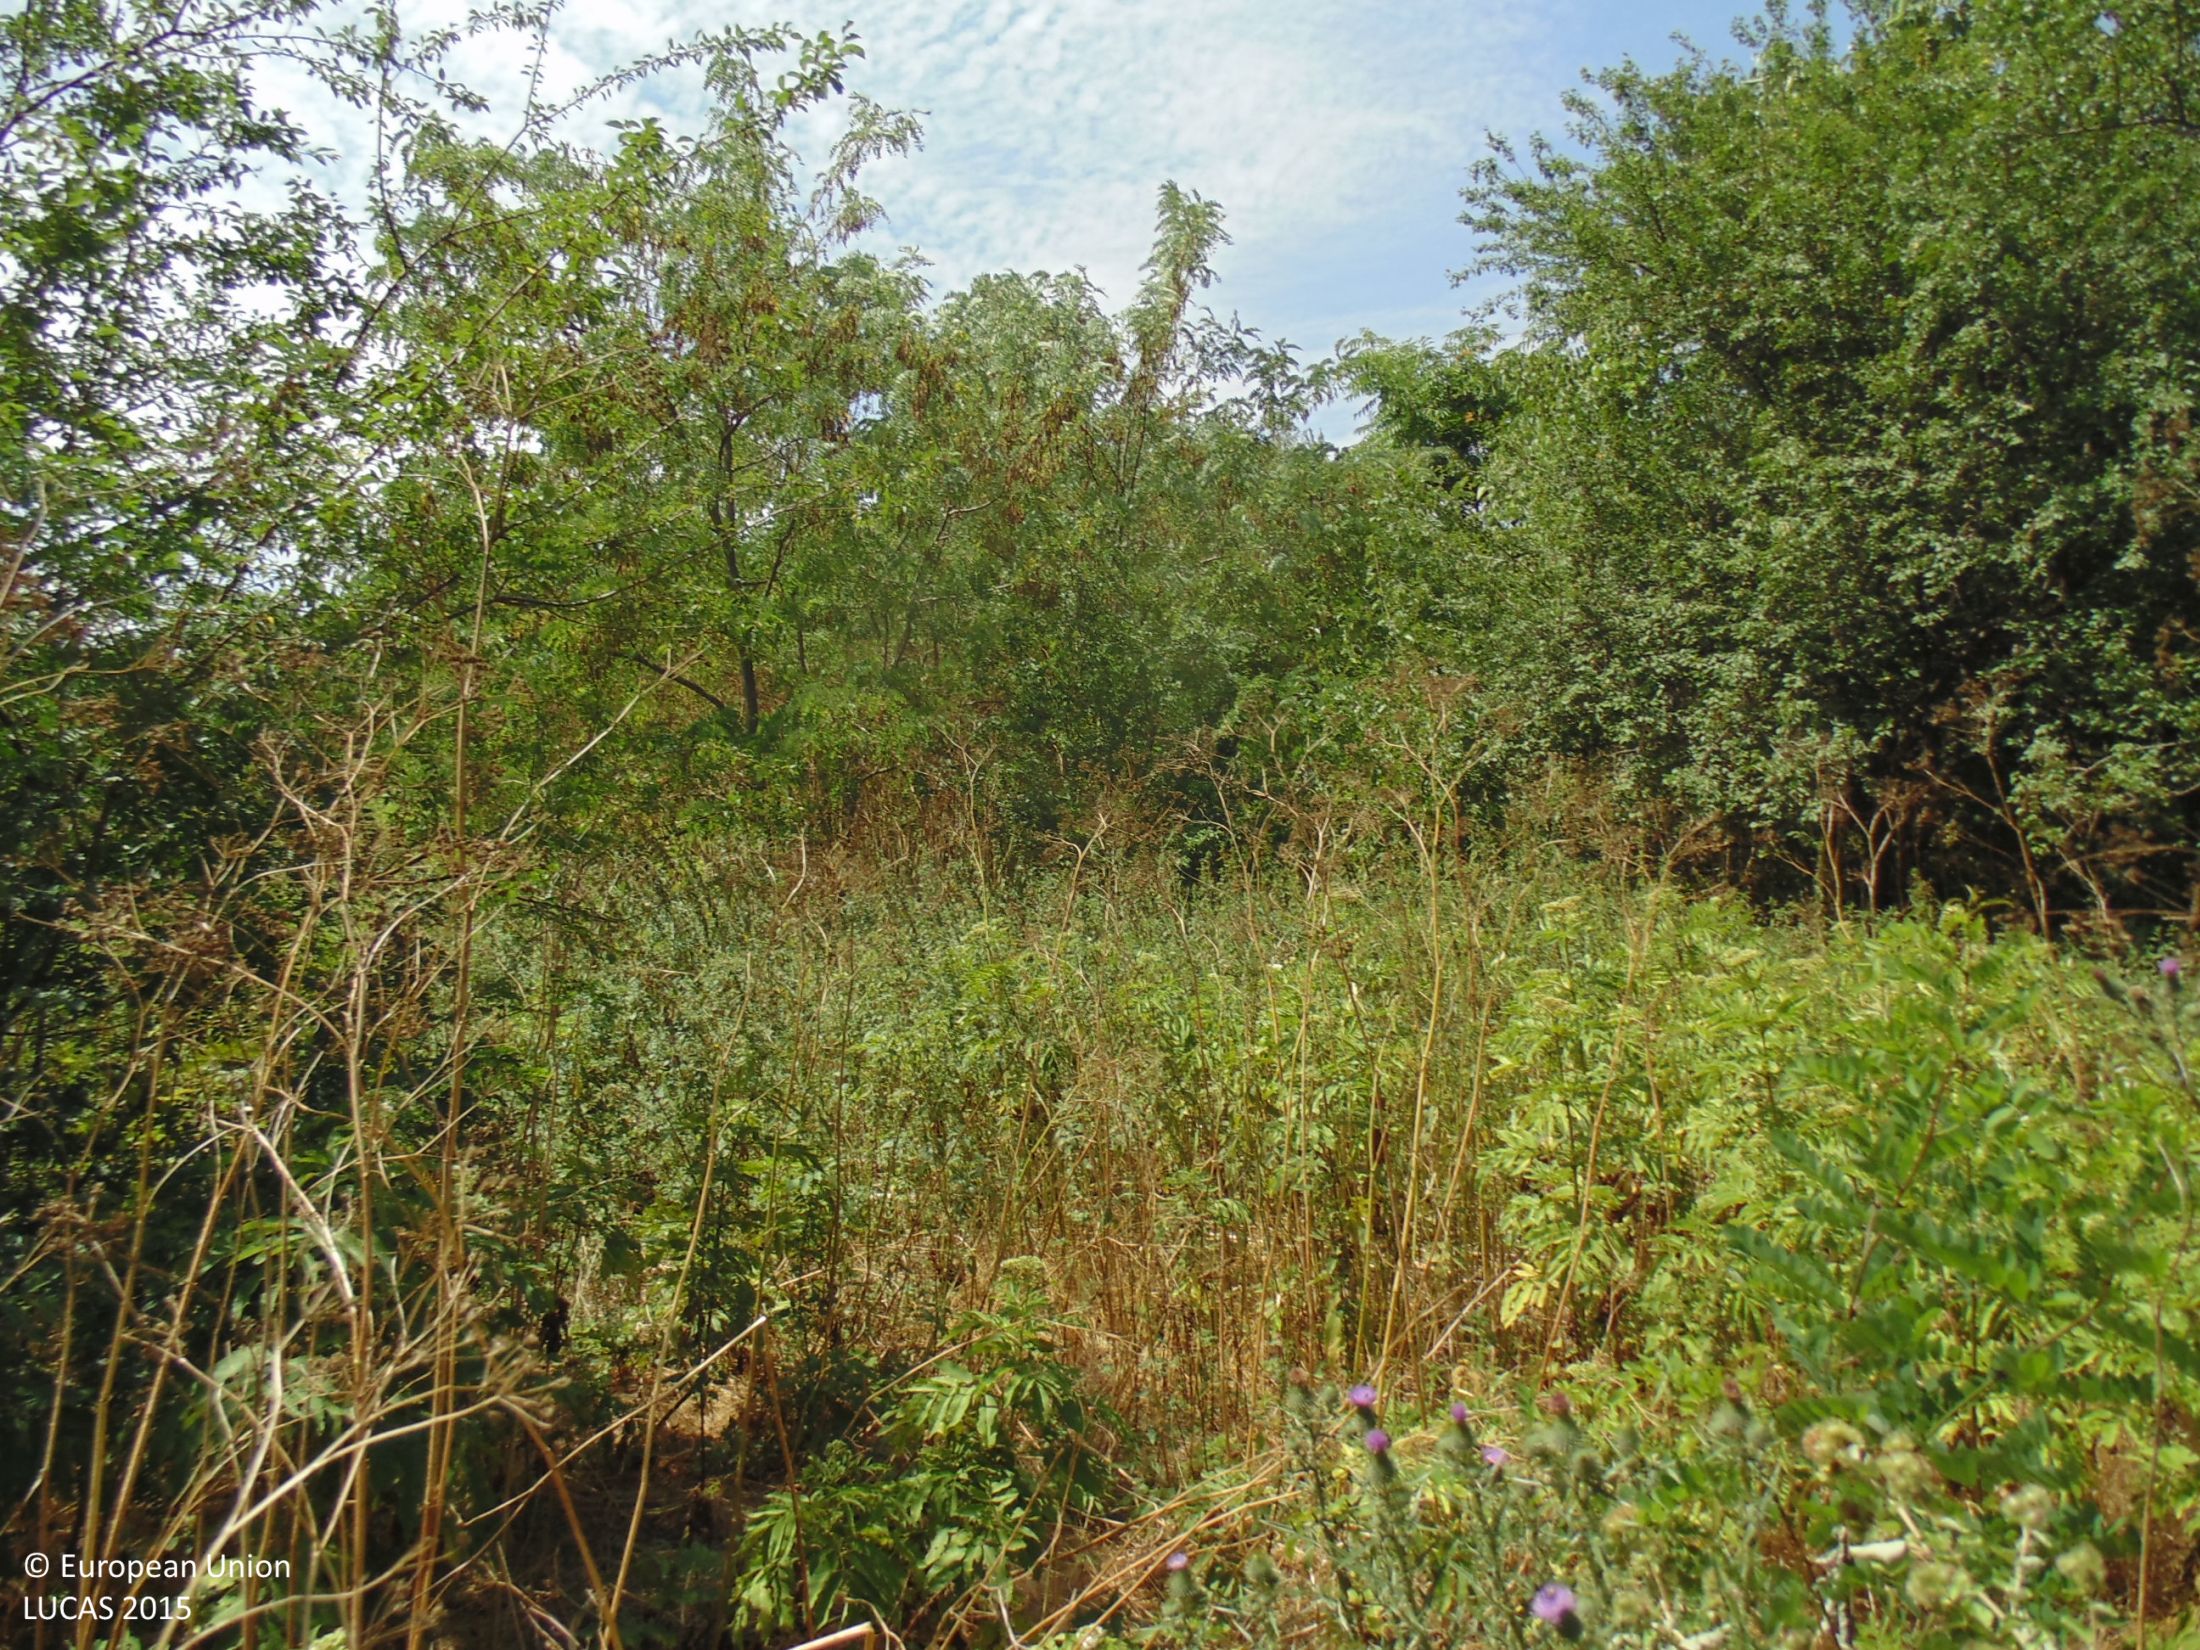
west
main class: Woodland
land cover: Broadleaved woodland
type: mesophytic deciduous forest
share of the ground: > 75 %
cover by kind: broadleaved forest trees 60 %, herbaceous plants 25 %, shrubs 15 %
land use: Semi-natural and natural areas not in use
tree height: > 5 m
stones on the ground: < 10 %
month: August
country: BG
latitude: 43.6135
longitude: 28.1810
